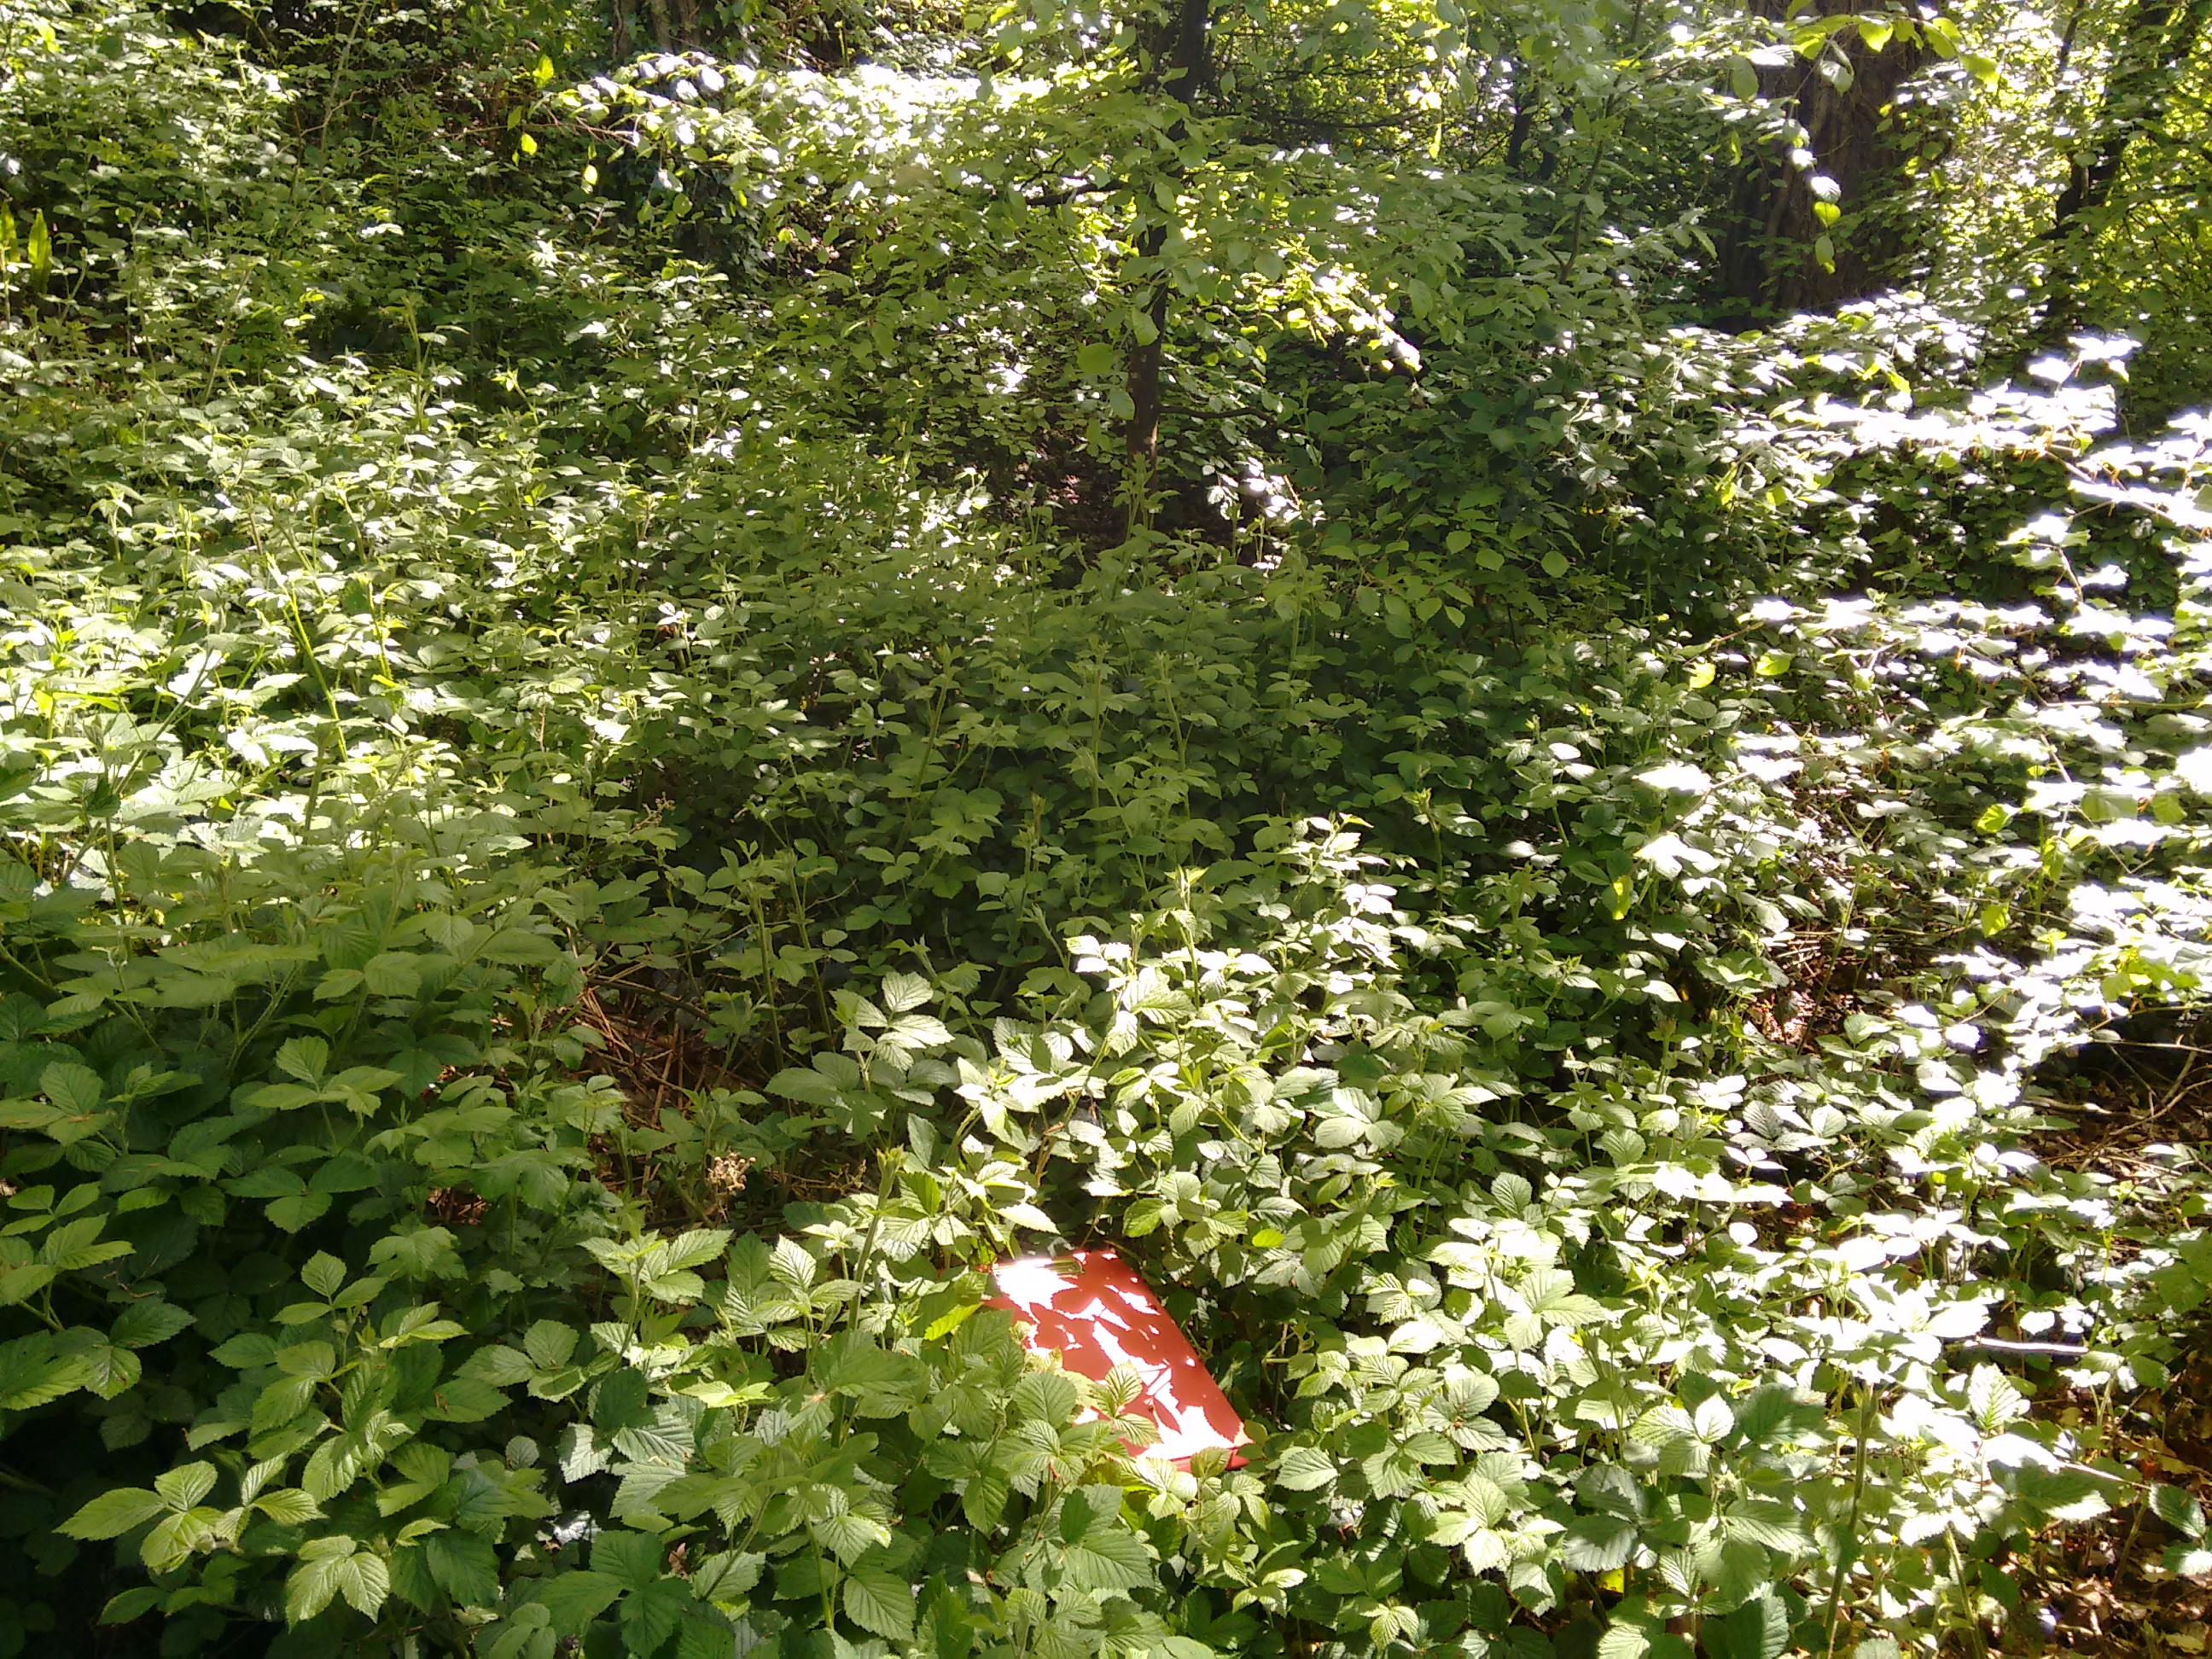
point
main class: Woodland
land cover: Broadleaved woodland
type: beech forest
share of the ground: > 75 %
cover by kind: broadleaved forest trees 85 %, shrubs 10 %, herbaceous plants 5 %
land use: Semi-natural and natural areas not in use
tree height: > 5 m
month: May
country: IE
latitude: 53.5901
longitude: -6.7056
